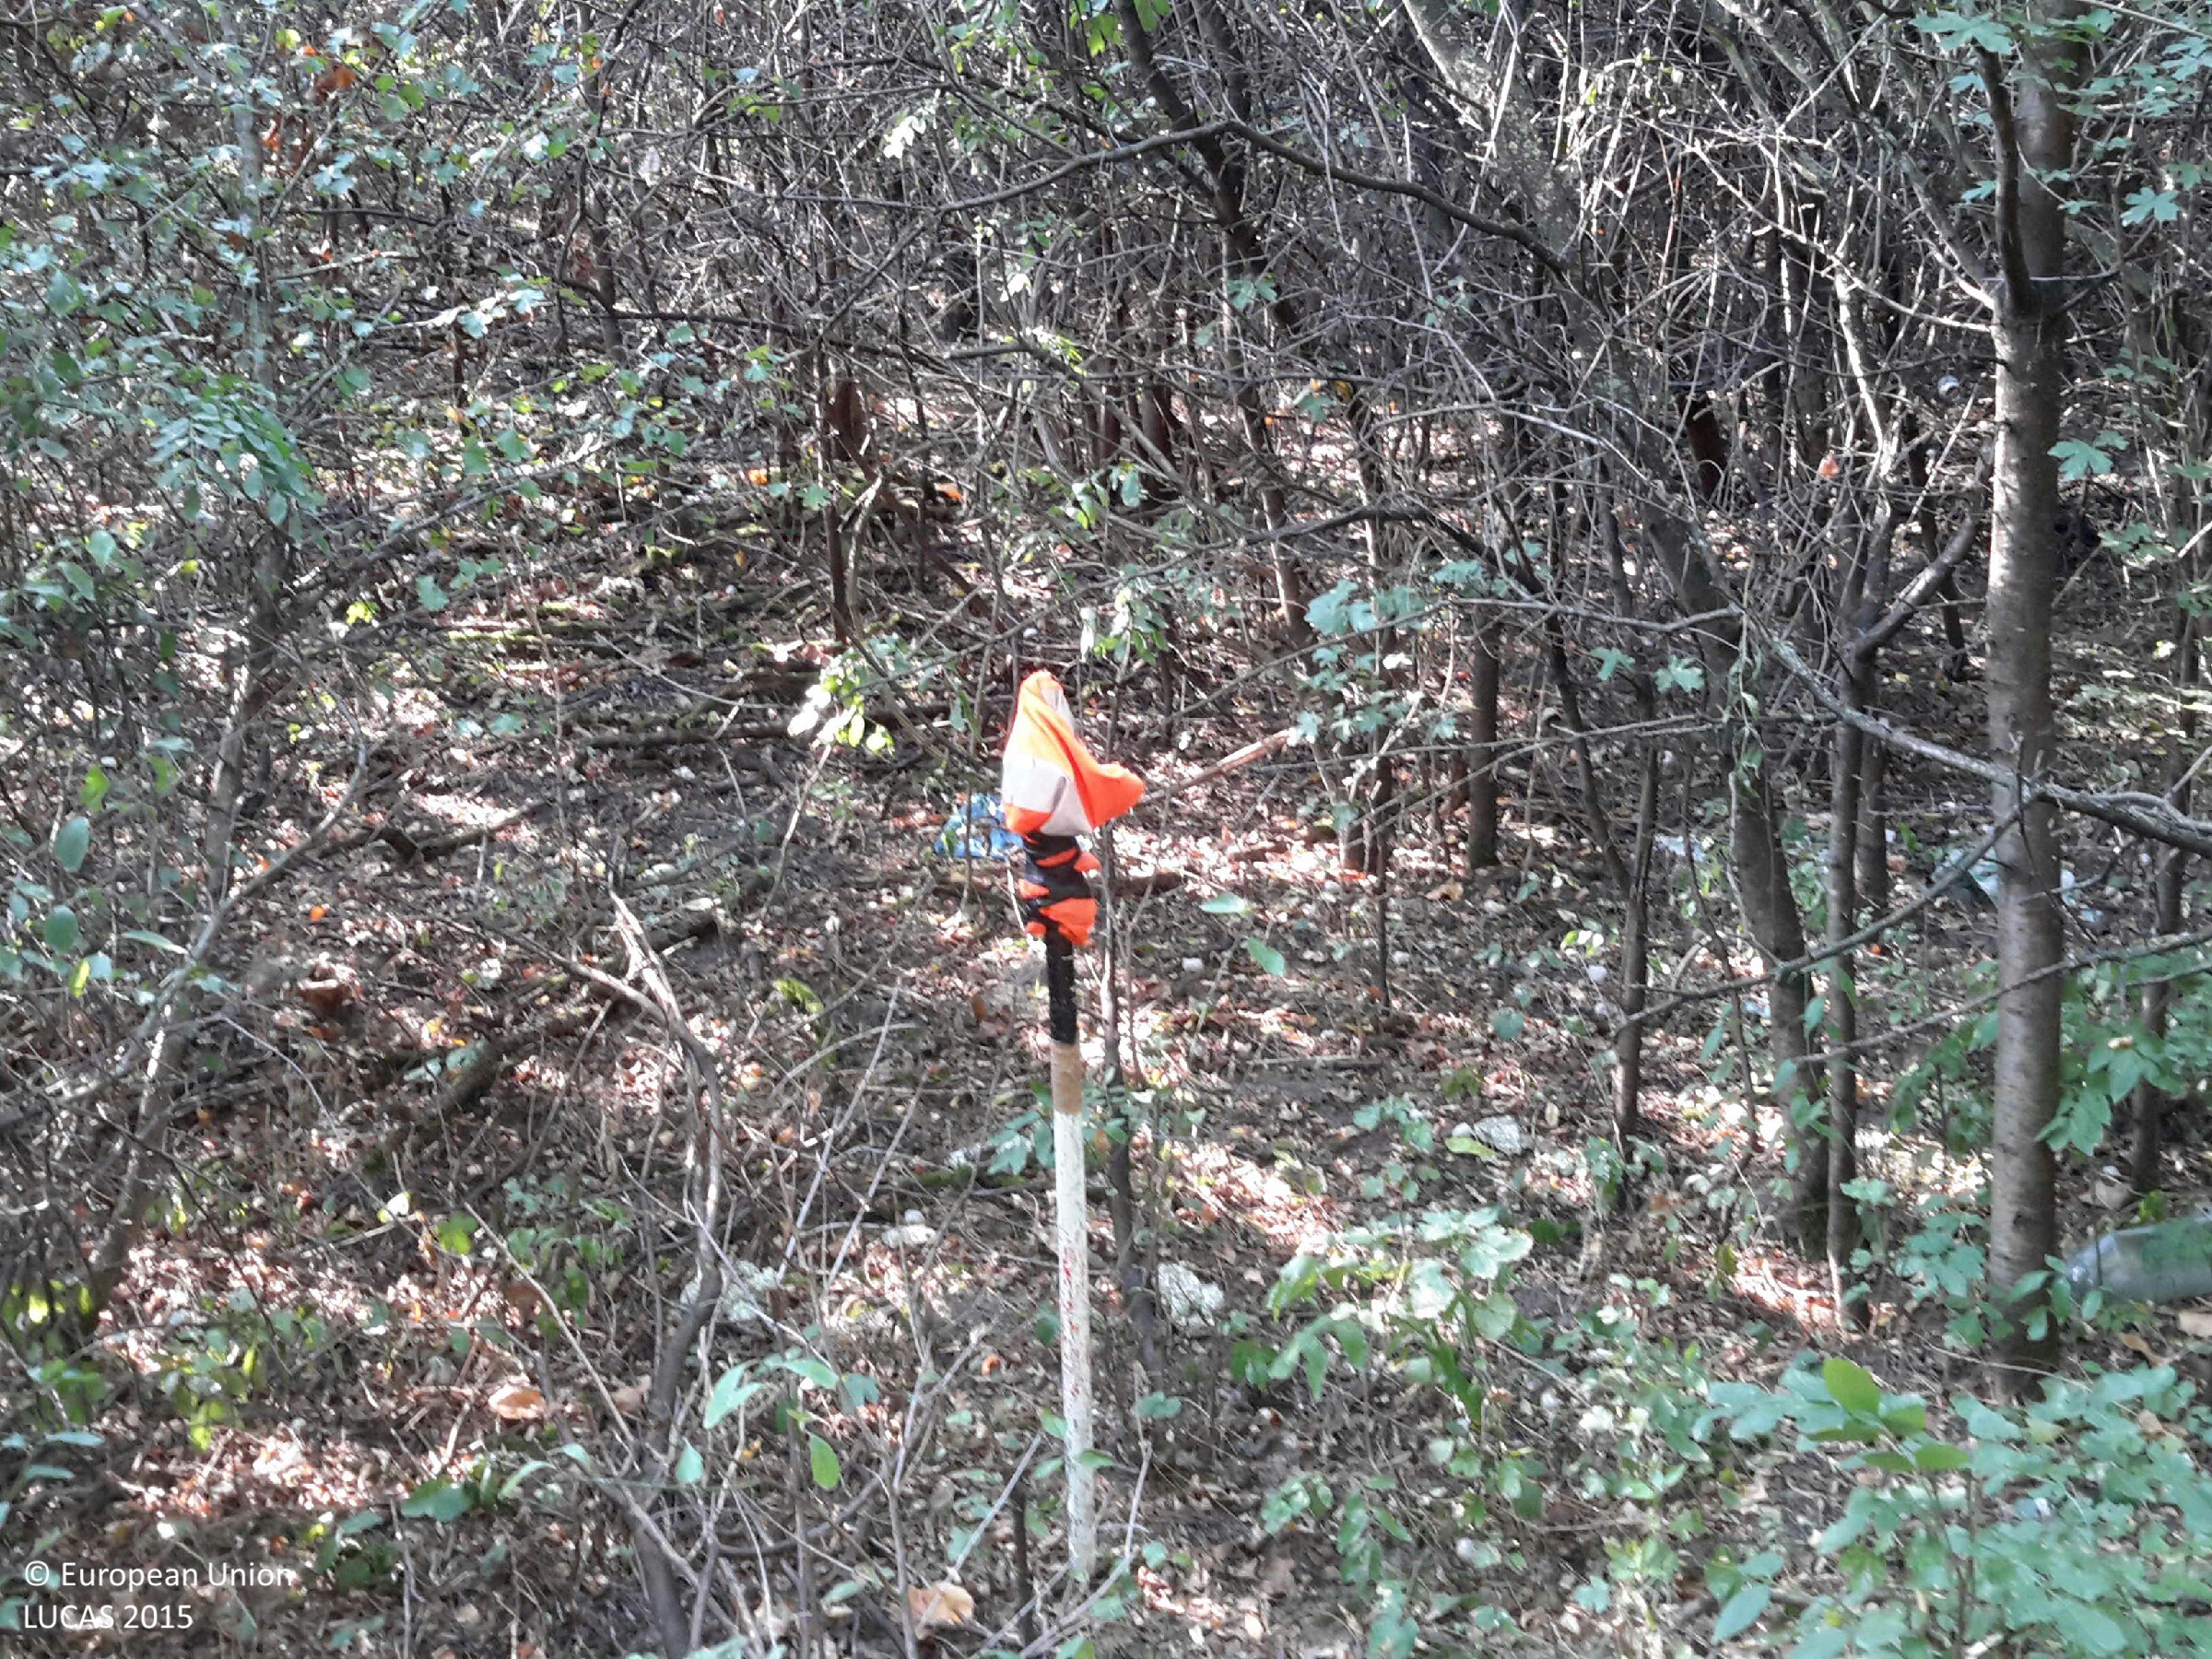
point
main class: Woodland
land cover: Broadleaved woodland
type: mesophytic deciduous forest
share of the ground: > 75 %
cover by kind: broadleaved forest trees 90 %, shrubs 5 %, herbaceous plants 5 %
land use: Forestry
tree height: > 5 m
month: August
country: HU
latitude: 47.9196
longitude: 17.1400
